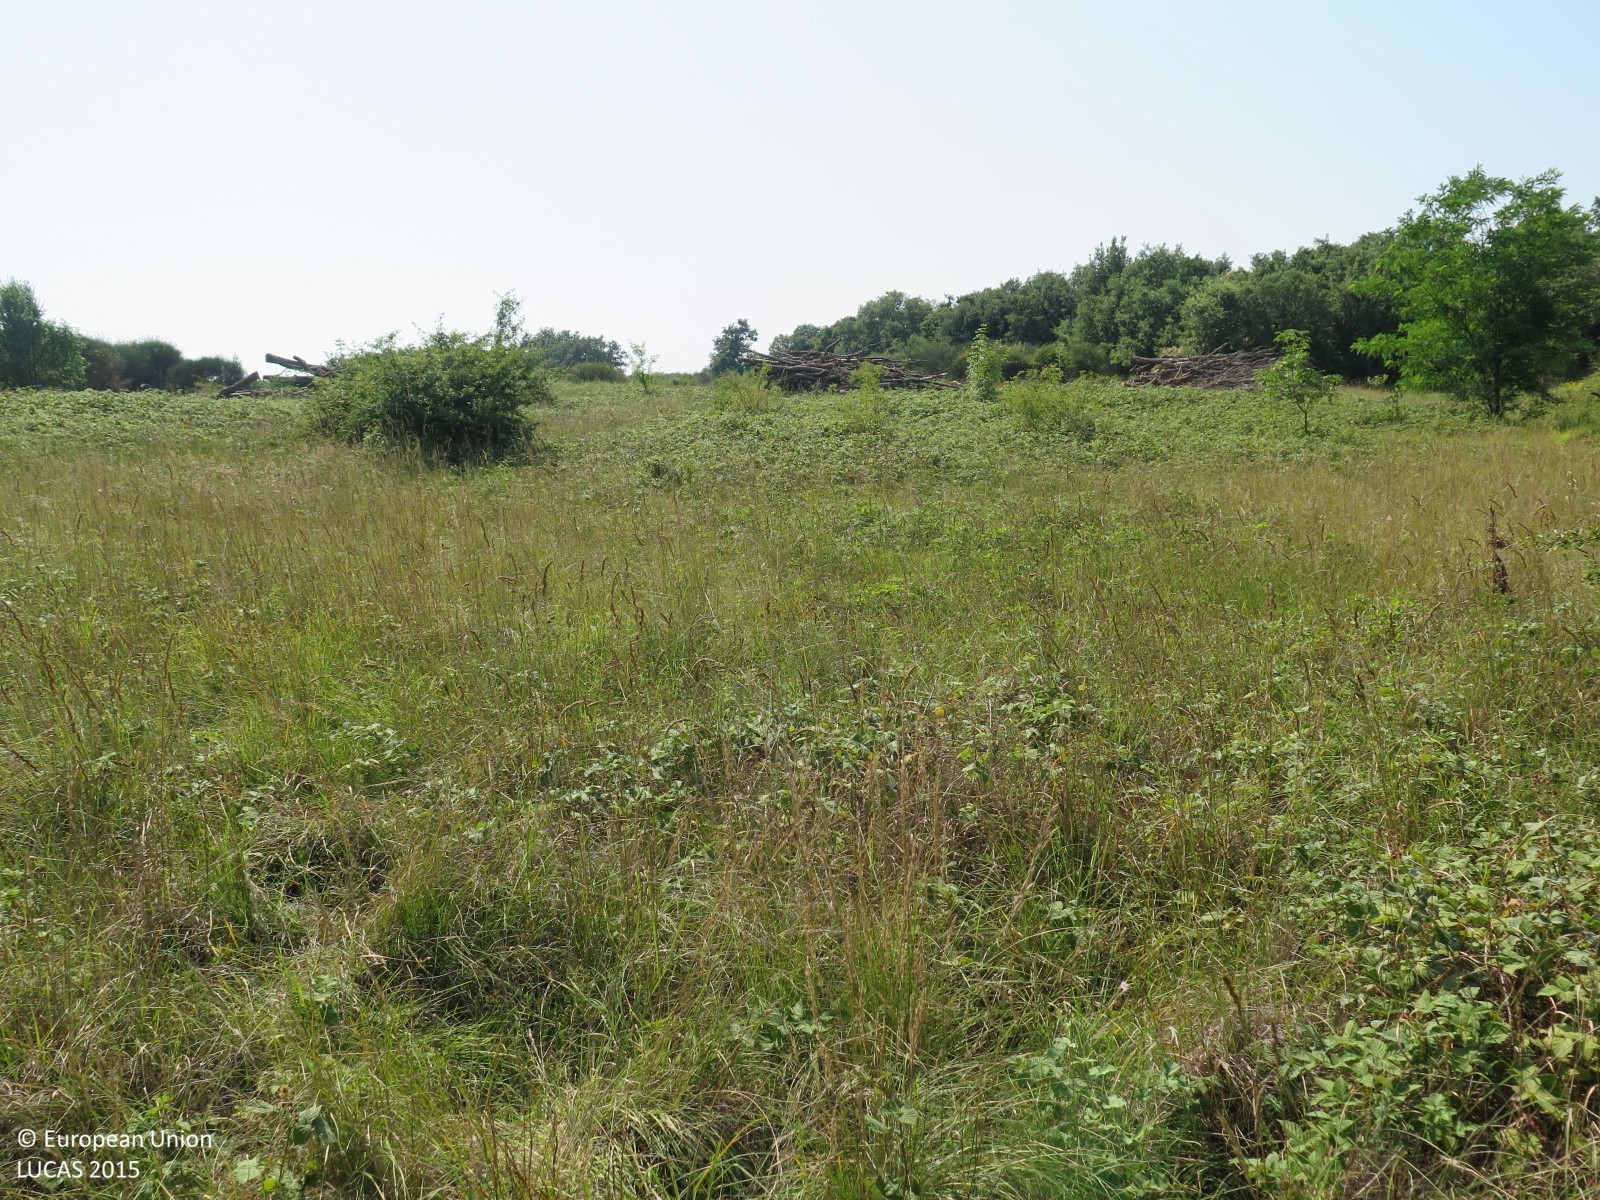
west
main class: Shrubland
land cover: Shrubland with sparse tree cover
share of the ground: > 75 %
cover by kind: shrubs 90 %, broadleaved forest trees 5 %, herbaceous plants 5 %
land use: Semi-natural and natural areas not in use
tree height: > 5 m
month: July
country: HR
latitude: 45.4820
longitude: 13.5136
